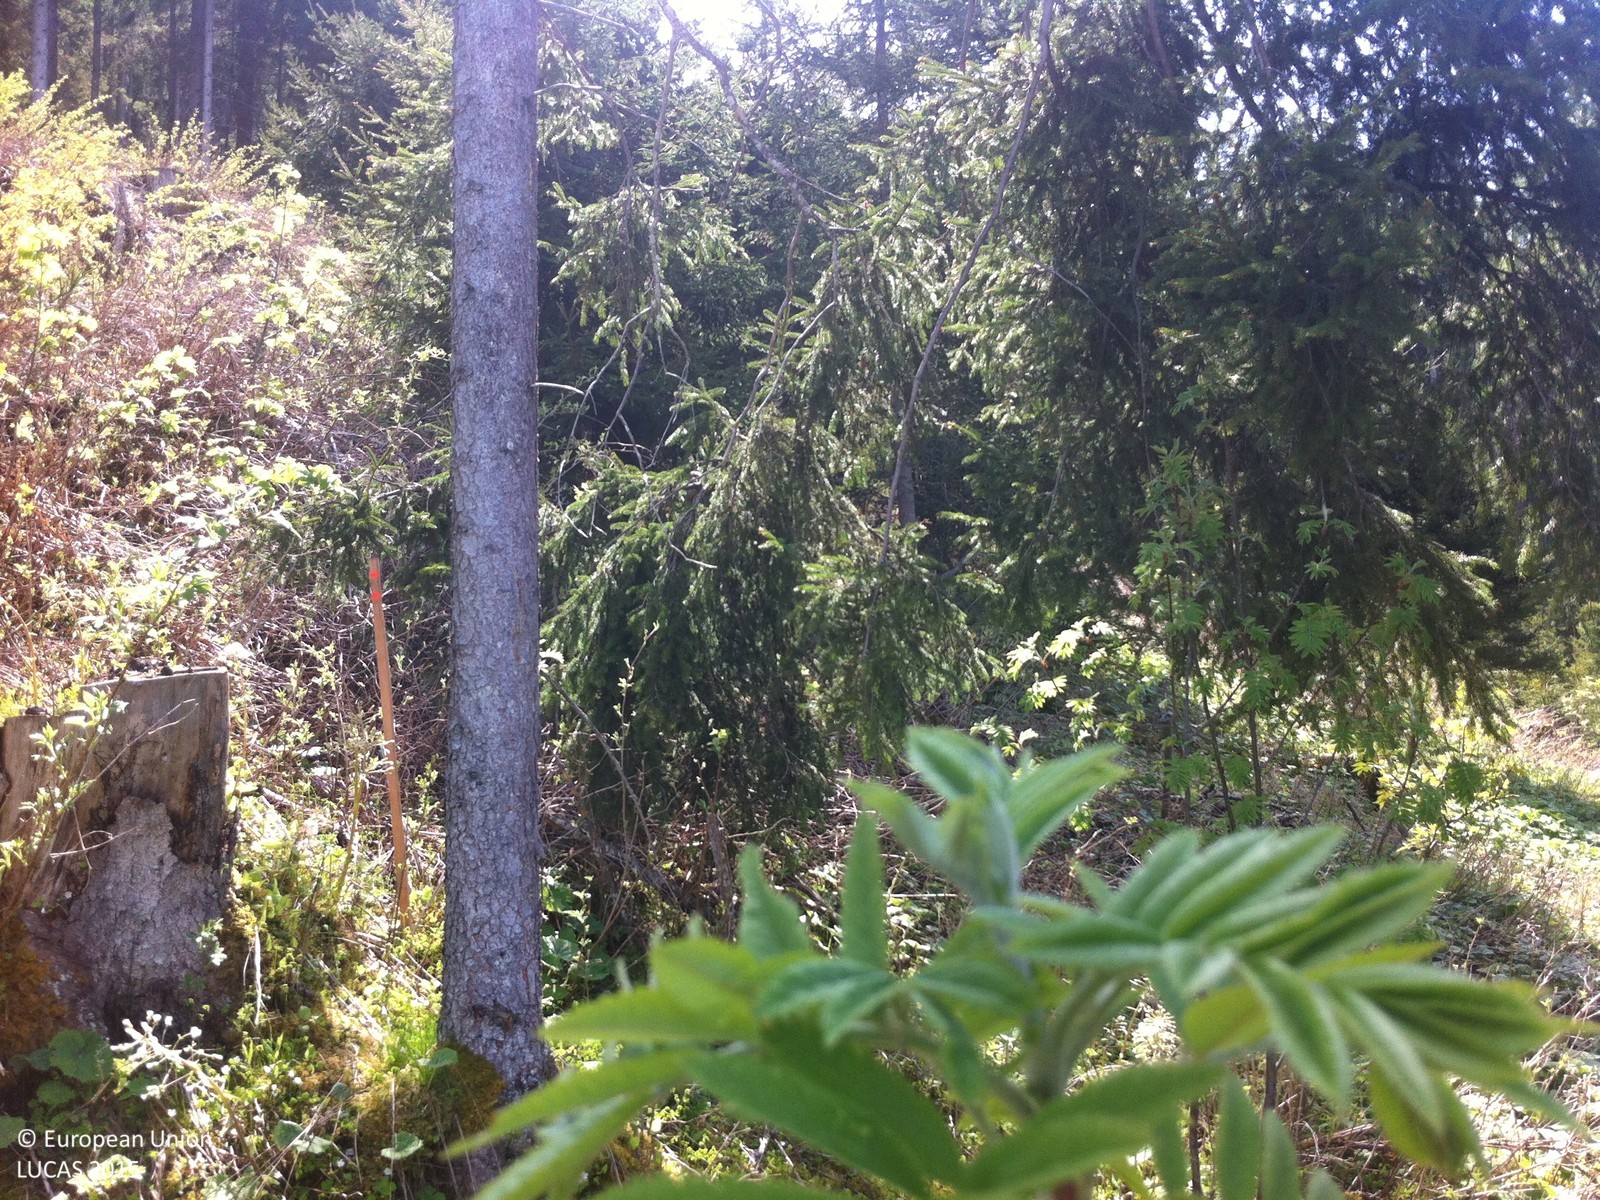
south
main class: Woodland
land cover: Other mixed woodland
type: alpine coniferous forest
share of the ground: > 75 %
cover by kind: coniferous forest trees 40 %, broadleaved forest trees 40 %, shrubs 20 %
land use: Forestry
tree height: < 5 m
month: May
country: AT
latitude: 47.2751
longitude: 11.6509
